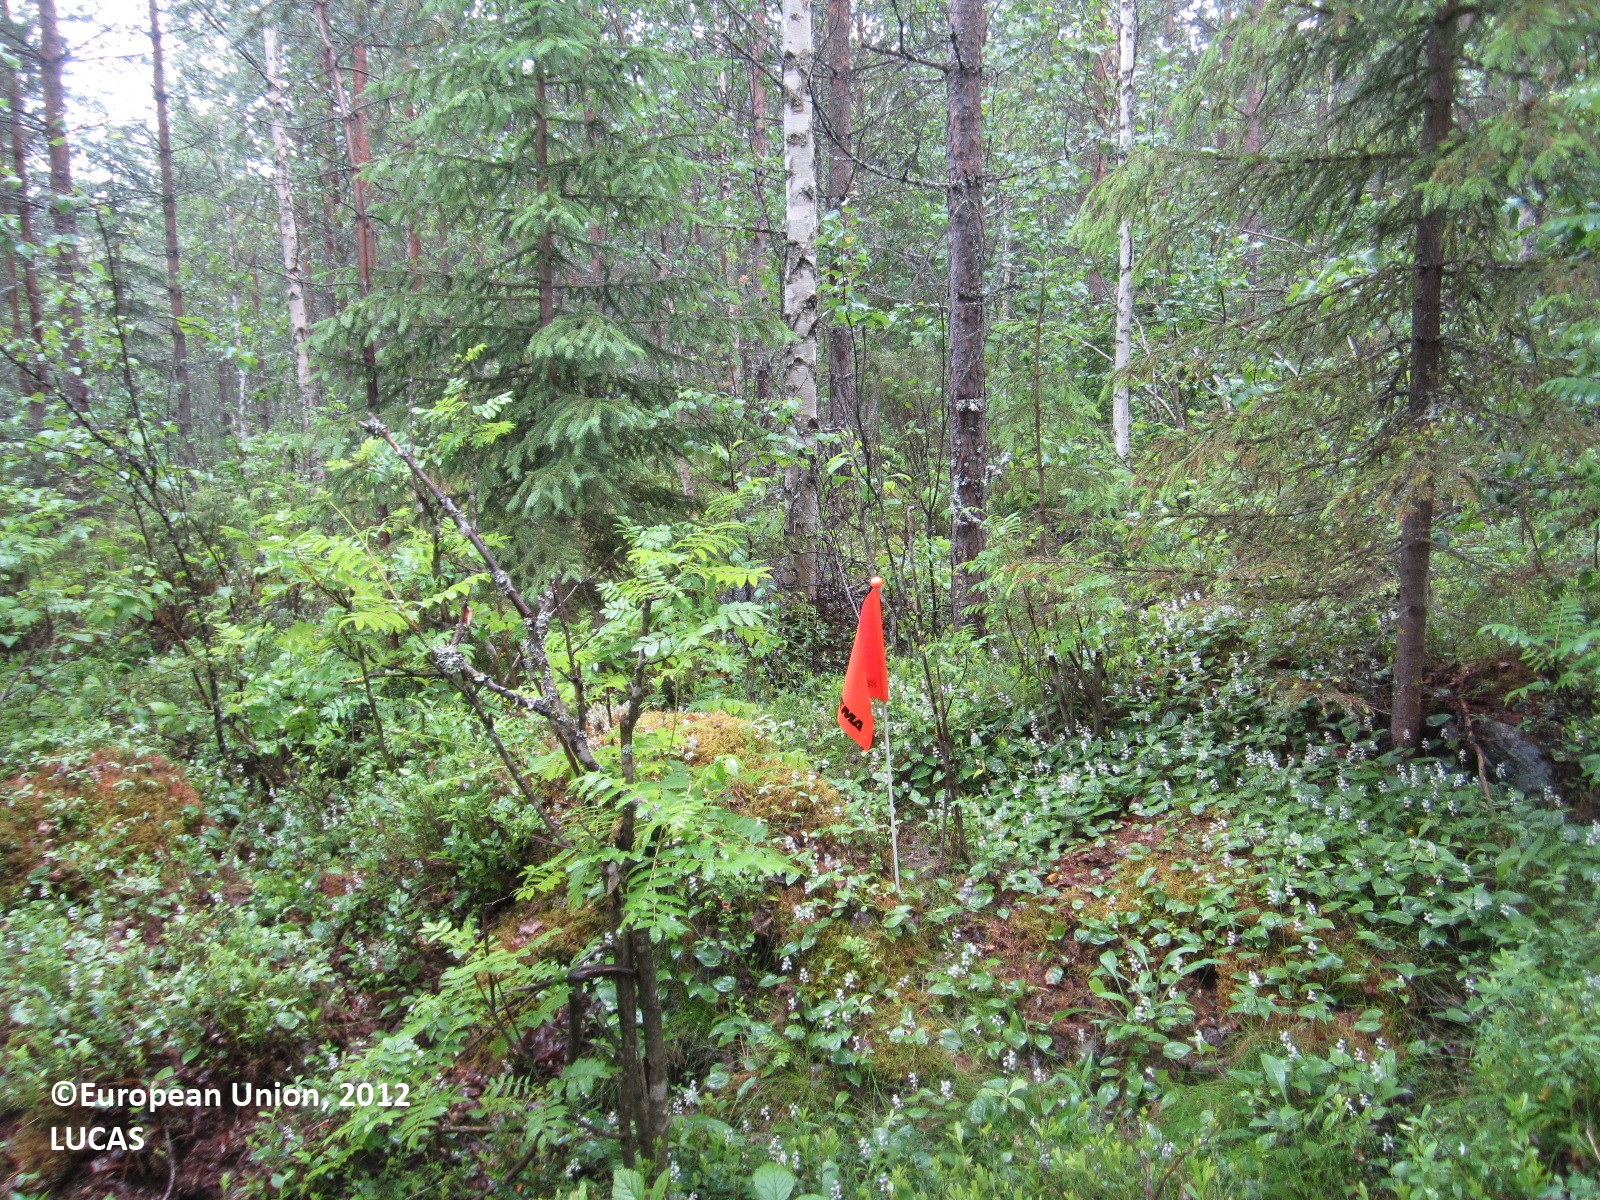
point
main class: Woodland
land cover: Pine dominated mixed woodland
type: boreal forest
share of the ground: > 75 %
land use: Forestry
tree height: > 5 m
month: June
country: FI
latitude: 64.5961
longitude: 29.3211
